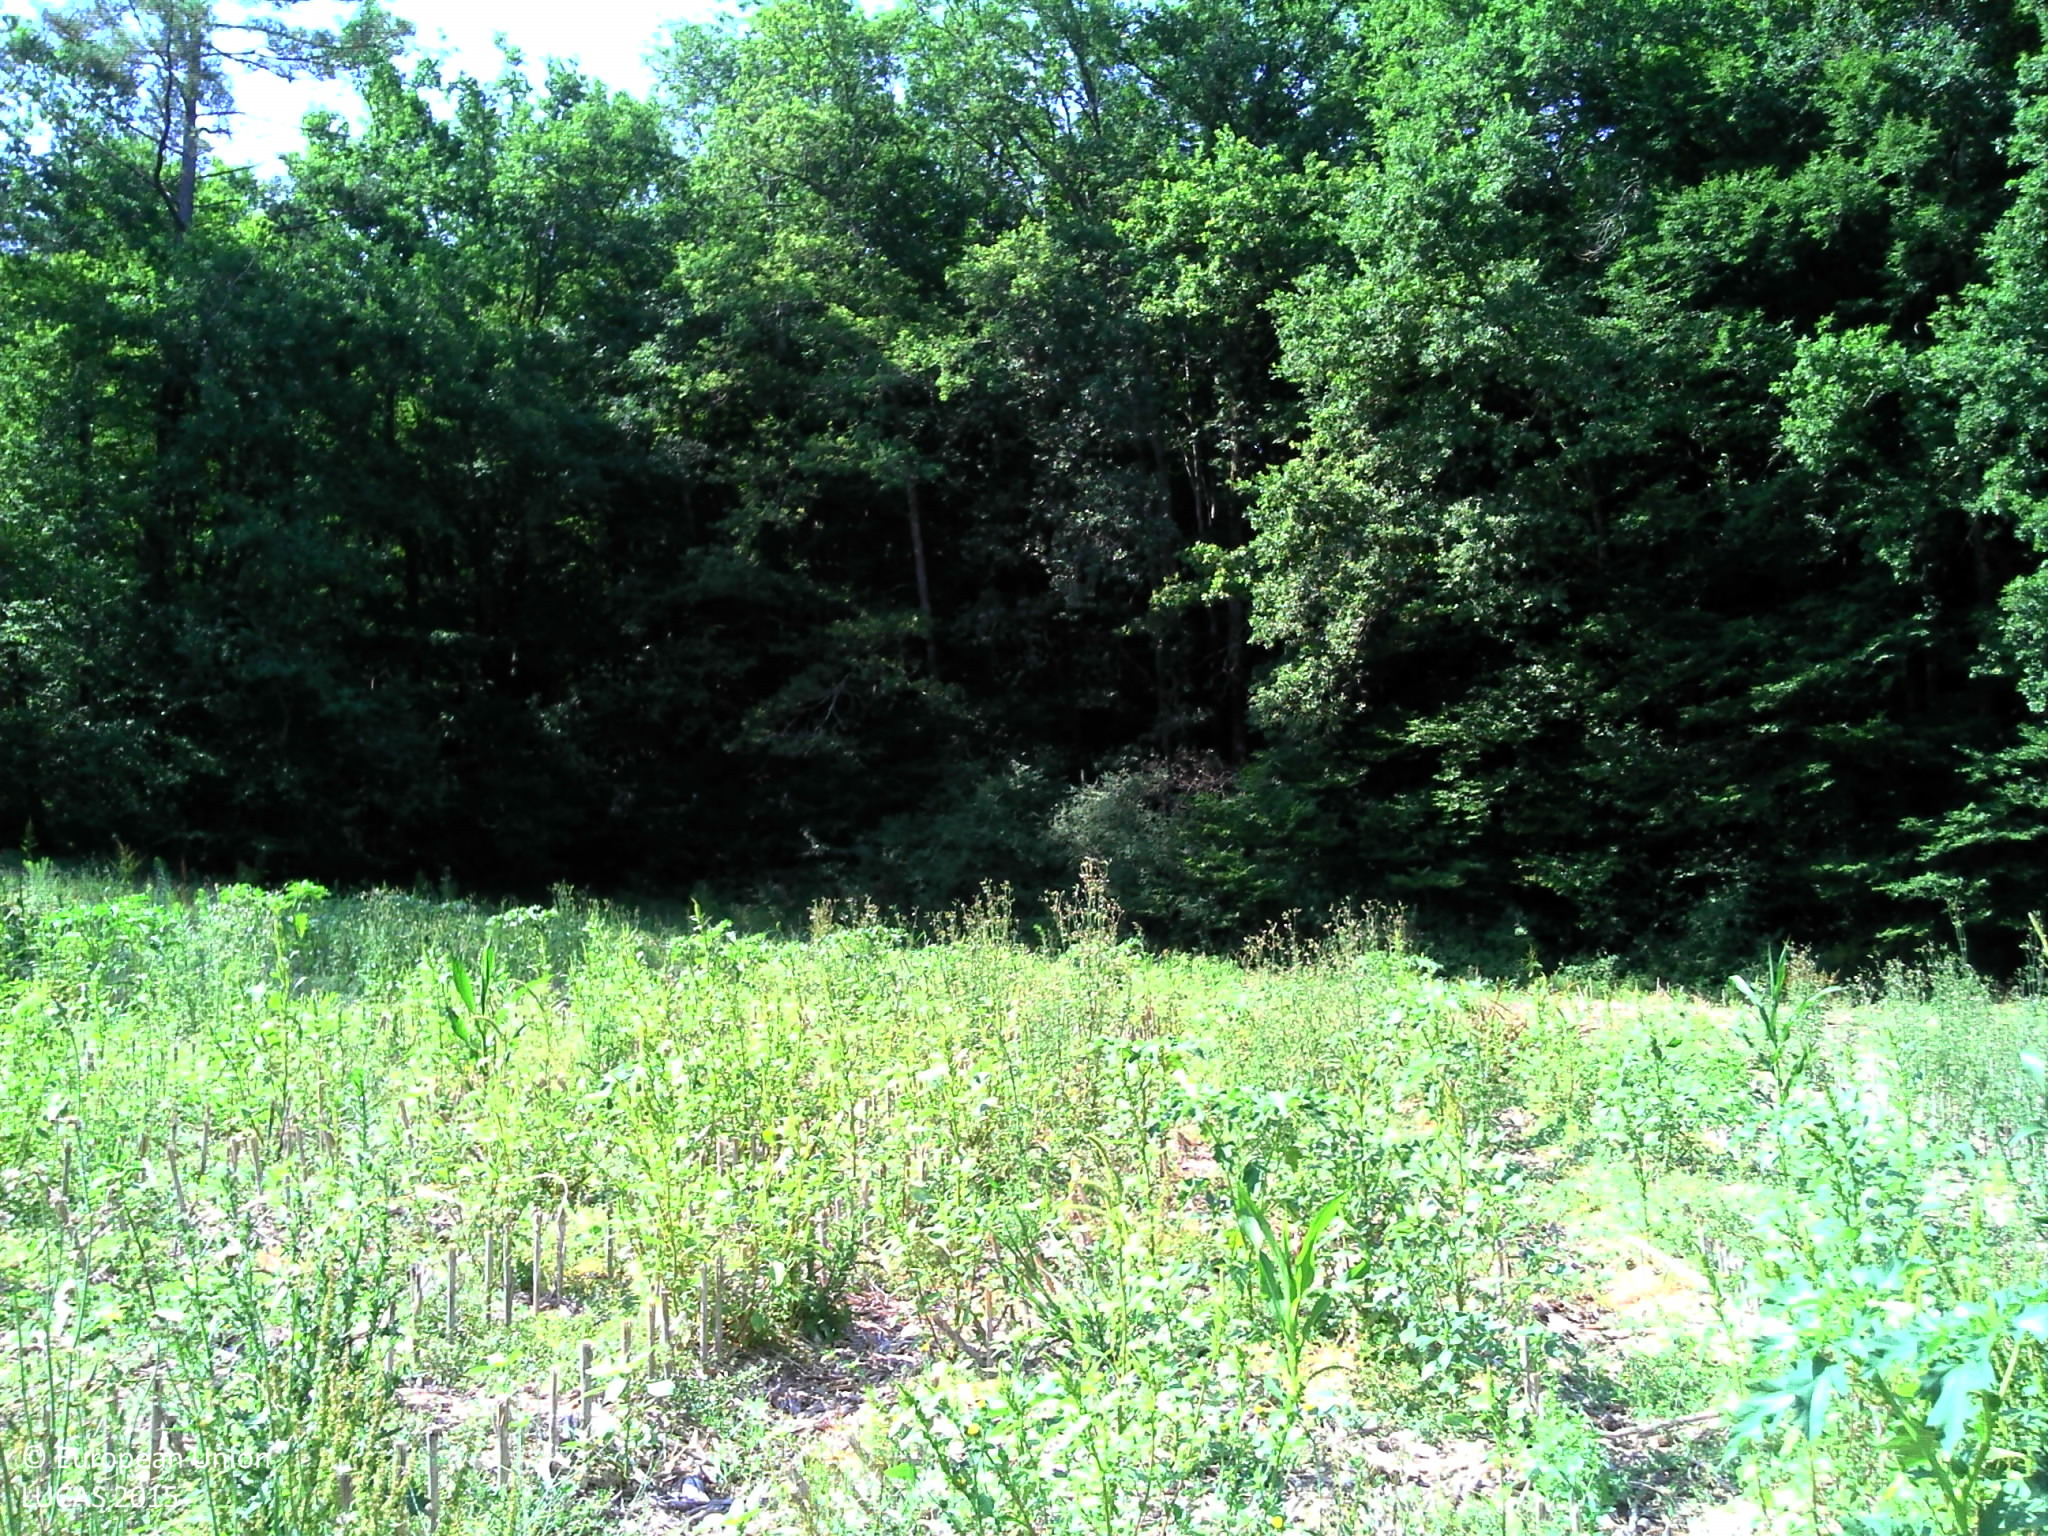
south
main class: Grassland
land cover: Spontaneously vegetated surfaces
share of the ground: 50 - 75 %
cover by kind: herbaceous plants 85 %, unconsolidated bare surface 15 %
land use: Fallow land
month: July
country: FR
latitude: 45.1134
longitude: 0.7242
